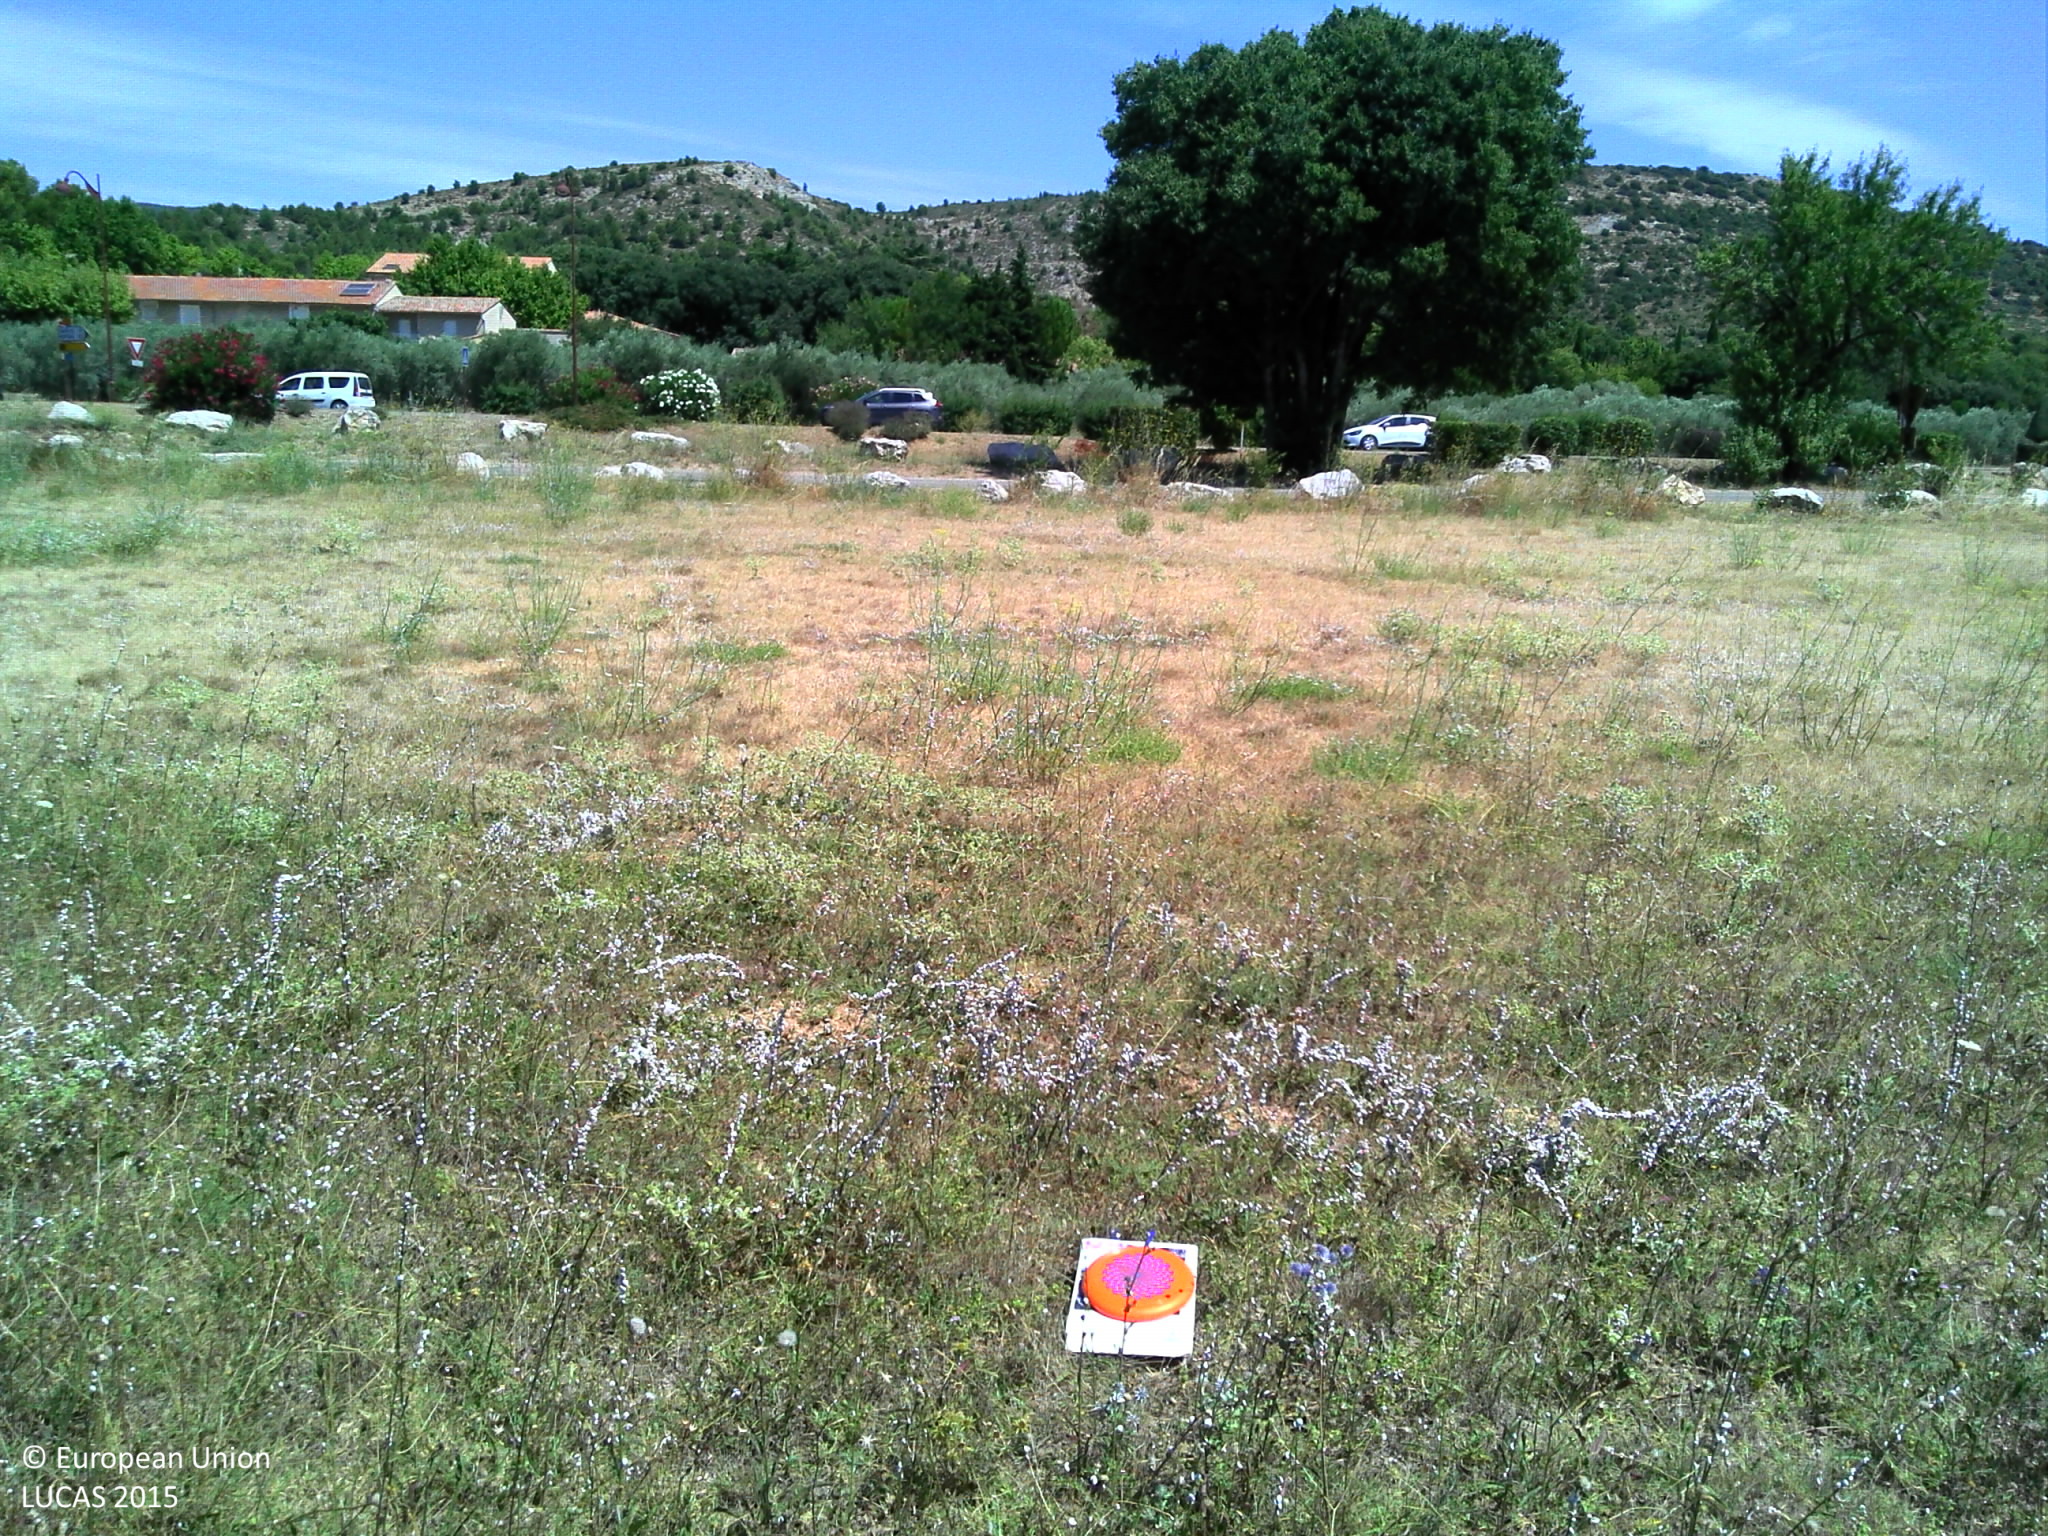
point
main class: Grassland
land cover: Grassland without tree/shrub cover
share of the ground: > 75 %
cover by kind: herbaceous plants 95 %, unconsolidated bare surface 5 %
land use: Agriculture (excluding fallow land and kitchen gardens)
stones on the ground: < 10 %
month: July
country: FR
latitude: 43.7518
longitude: 5.2029
